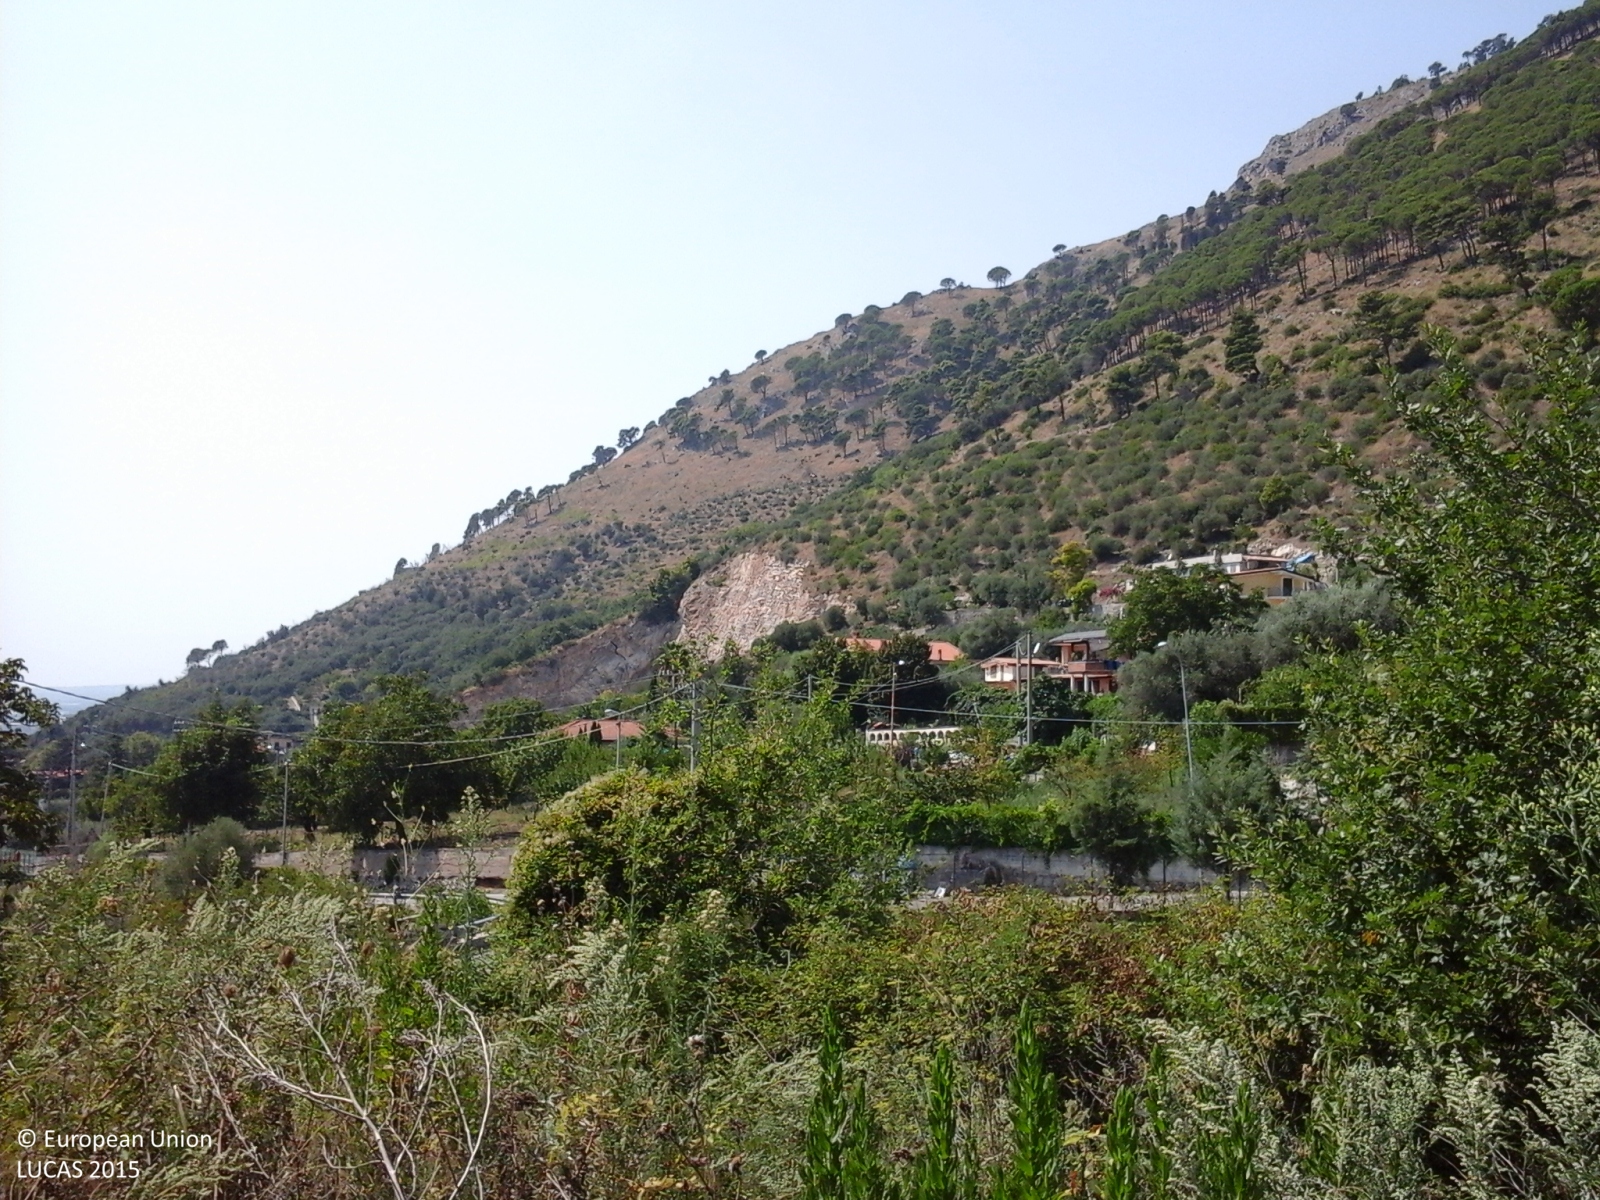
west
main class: Shrubland
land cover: Shrubland without tree cover
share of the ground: > 75 %
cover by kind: shrubs 50 %, herbaceous plants 50 %
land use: Fallow land
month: August
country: IT
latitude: 40.8100
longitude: 14.6398
